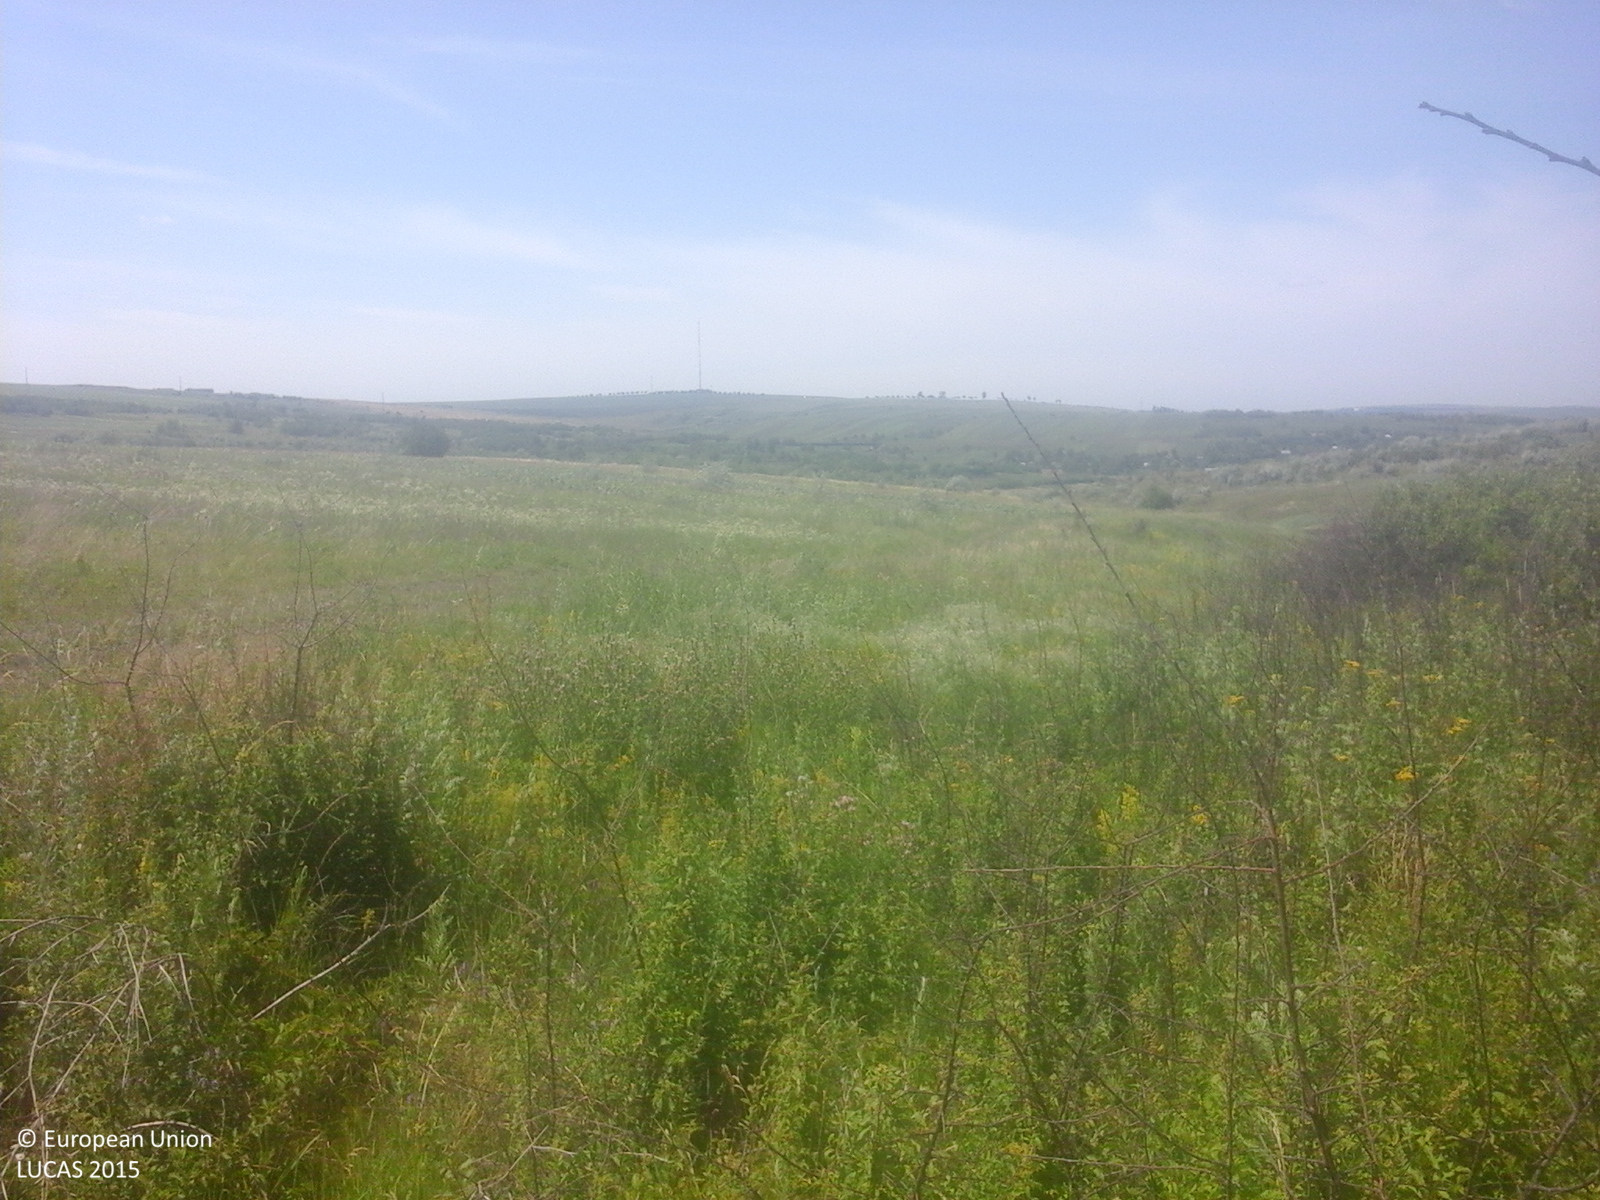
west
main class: Shrubland
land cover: Shrubland without tree cover
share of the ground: > 75 %
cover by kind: shrubs 80 %, herbaceous plants 20 %
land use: Semi-natural and natural areas not in use
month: June
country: RO
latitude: 47.9176
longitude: 26.8965
